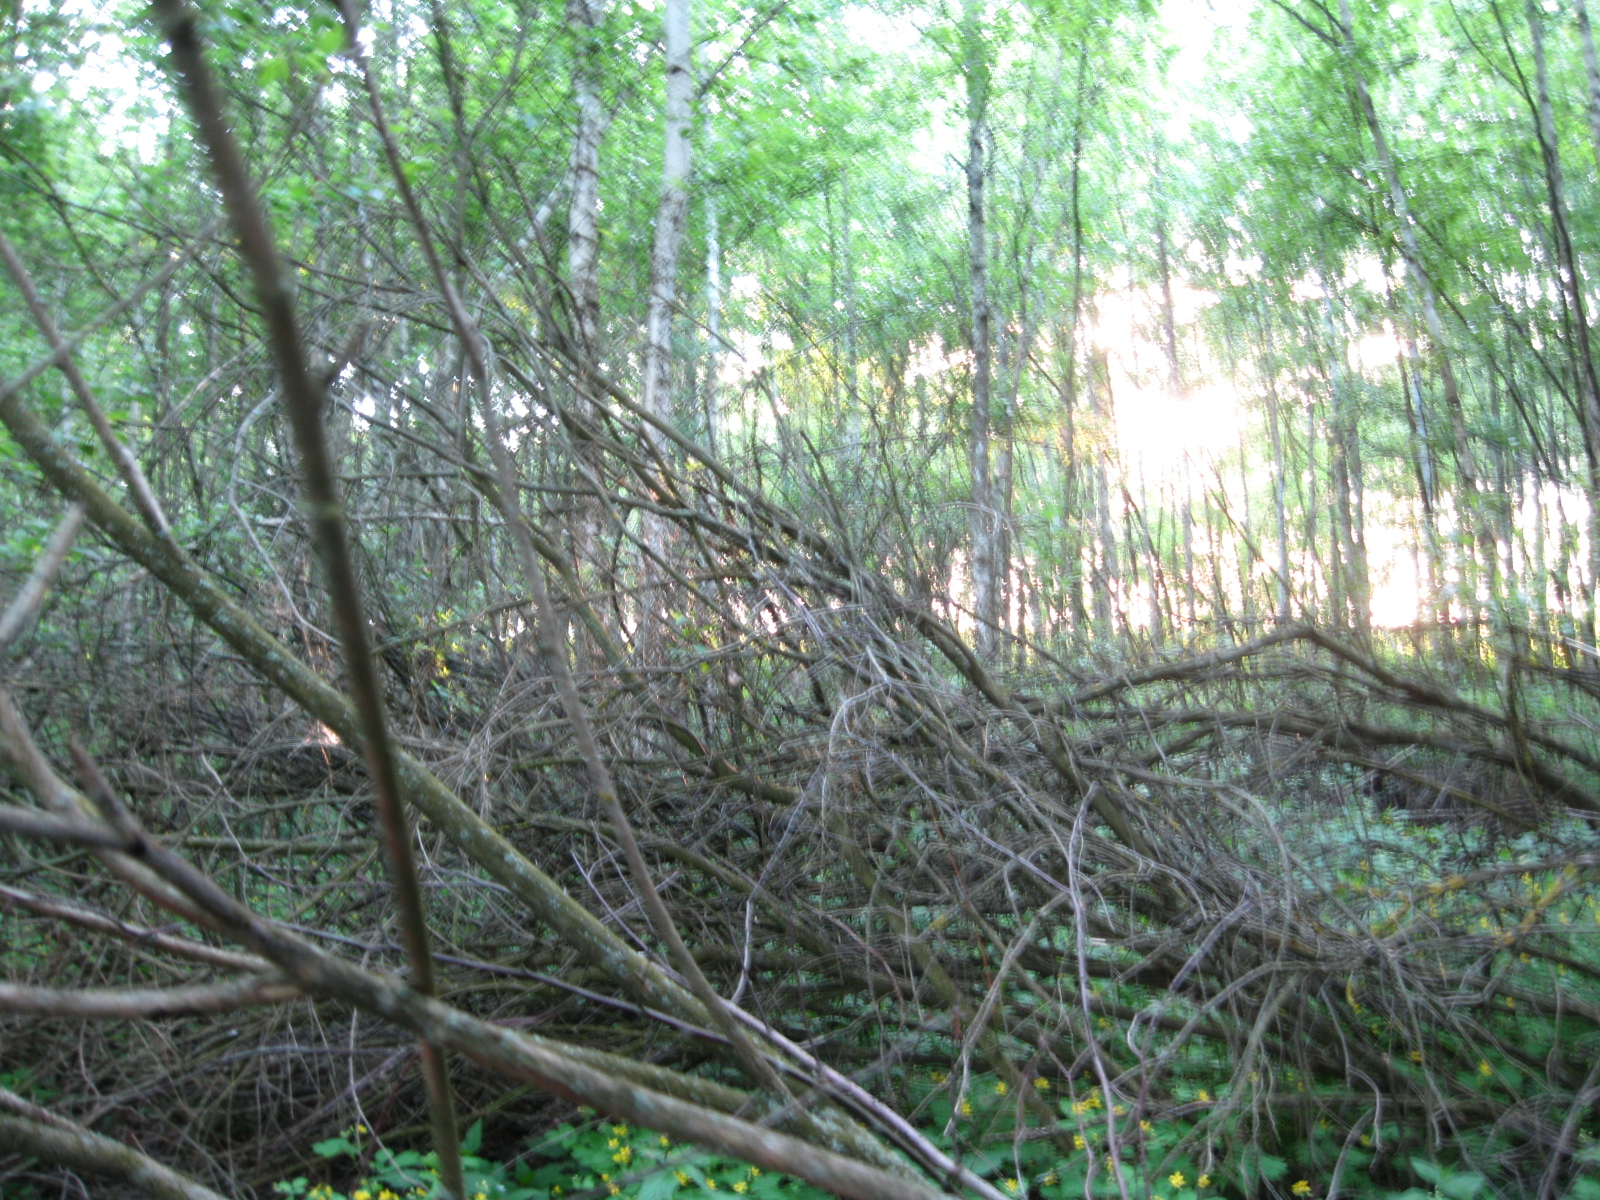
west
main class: Woodland
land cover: Broadleaved woodland
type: non-riverine alder, birch or aspen forest
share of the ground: > 75 %
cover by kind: broadleaved forest trees 85 %, herbaceous plants 15 %
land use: Semi-natural and natural areas not in use
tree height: > 5 m
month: May
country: LT
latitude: 55.9431
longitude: 24.8201
